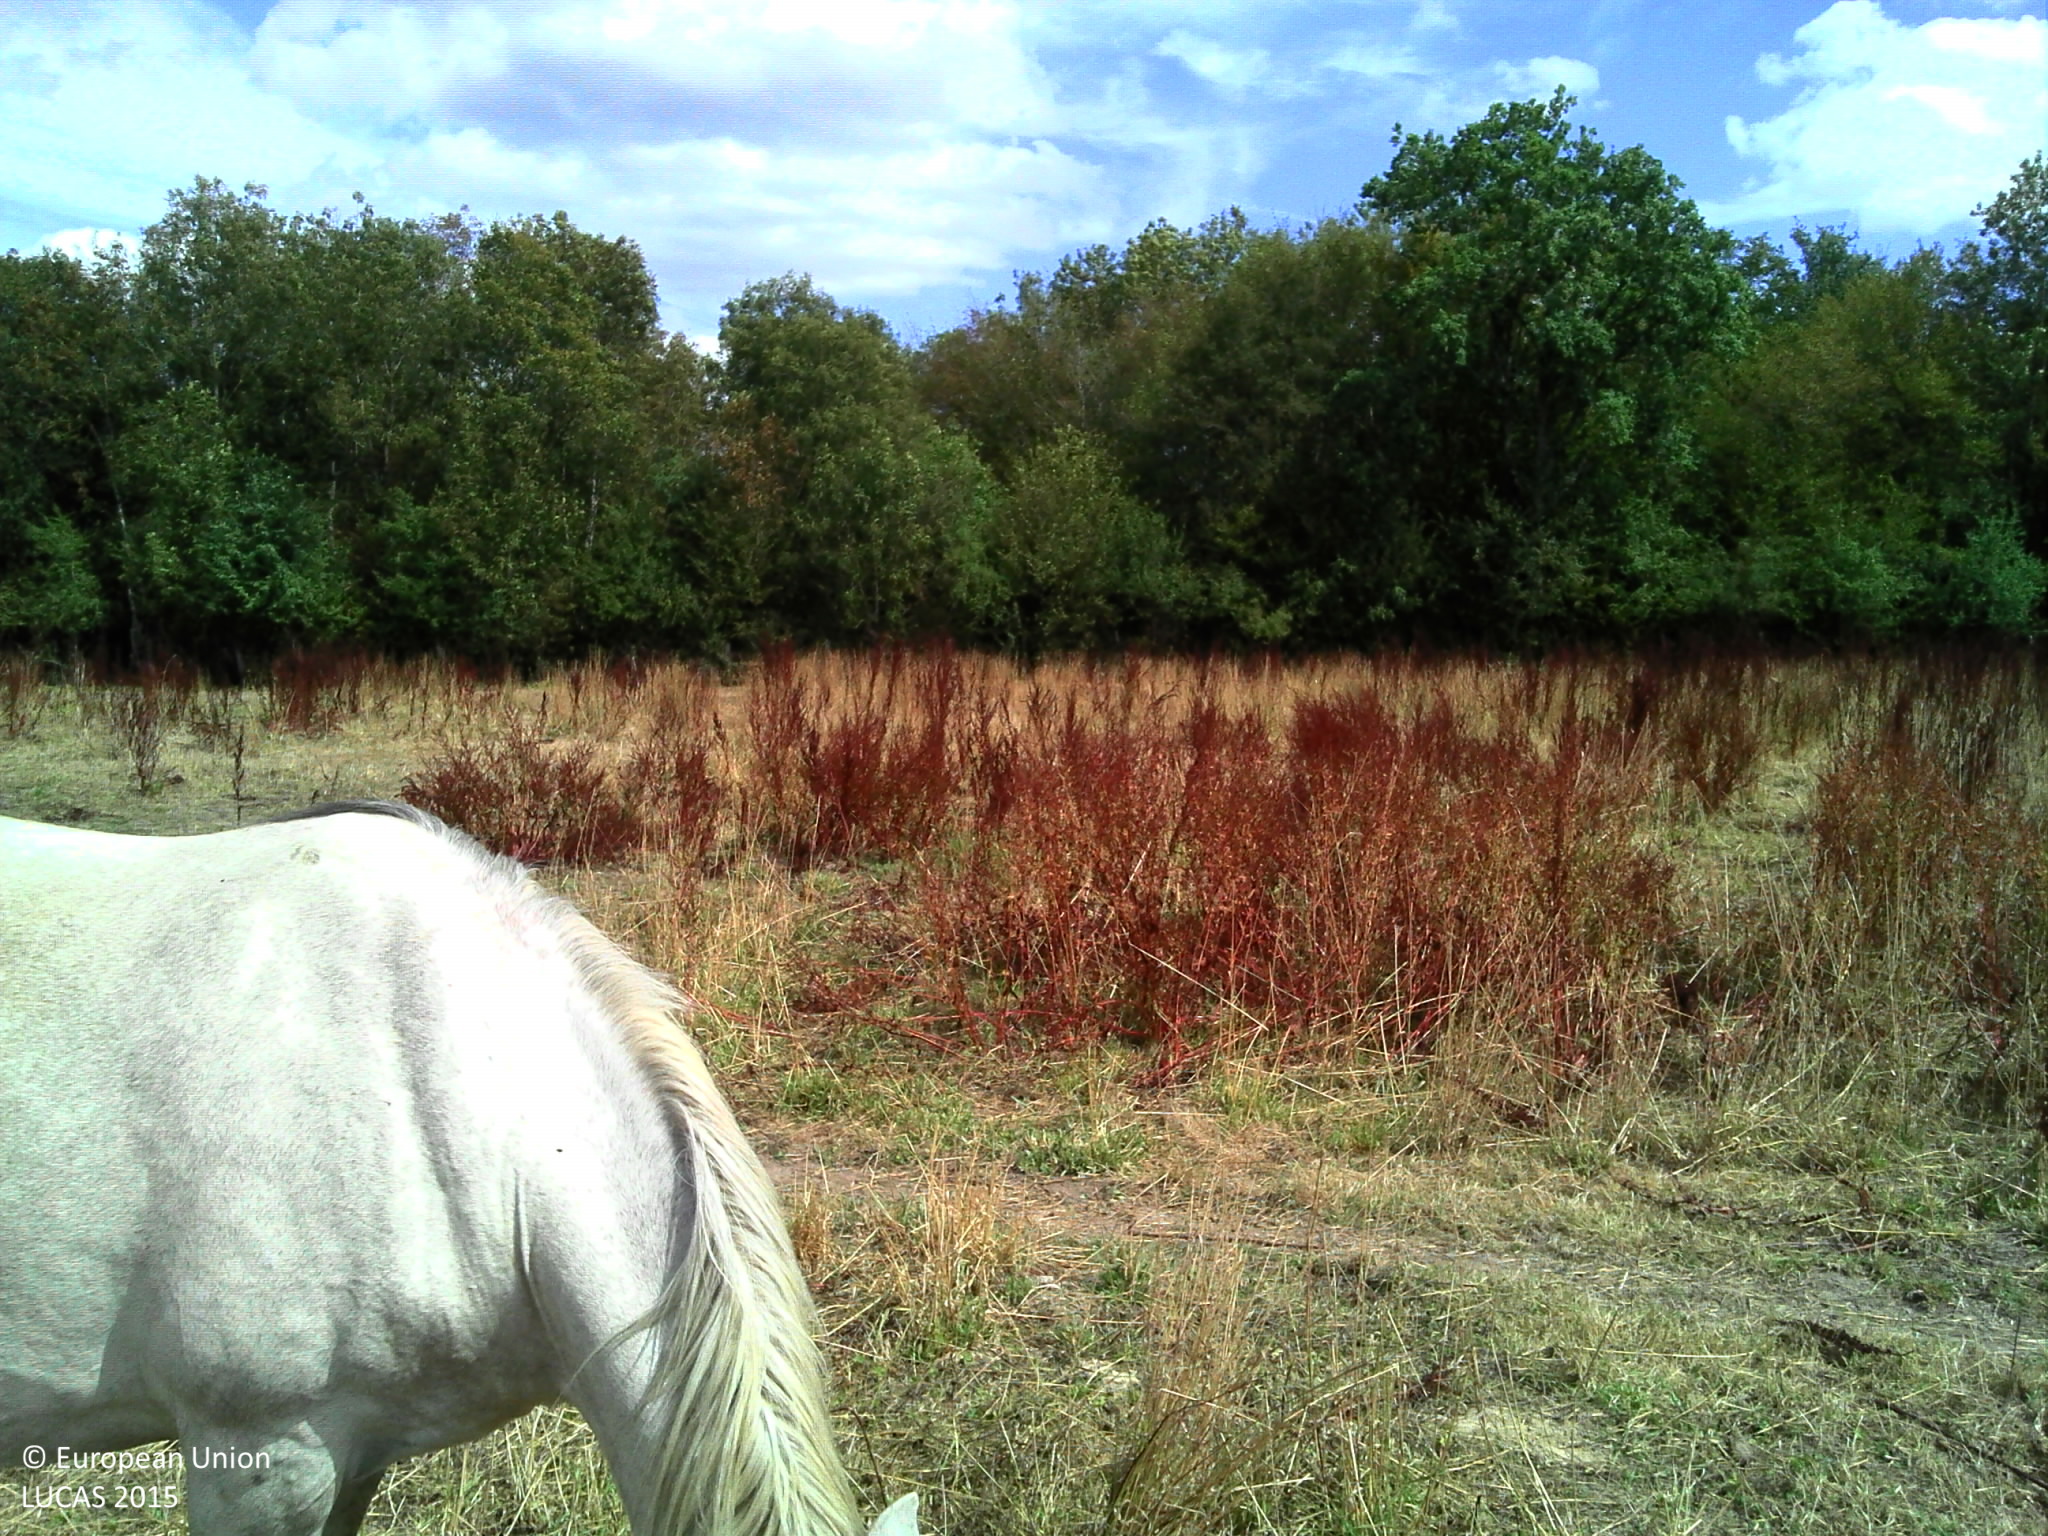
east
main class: Grassland
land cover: Grassland without tree/shrub cover
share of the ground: > 75 %
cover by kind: herbaceous plants 80 %, unconsolidated bare surface 20 %
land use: Agriculture (excluding fallow land and kitchen gardens)
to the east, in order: Grassland without tree/shrub cover; Fences; Broadleaved woodland; Fences; Grassland without tree/shrub cover; Abandoned hedges; Grassland without tree/shrub cover
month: July
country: FR
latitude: 47.8259
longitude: 3.0878
